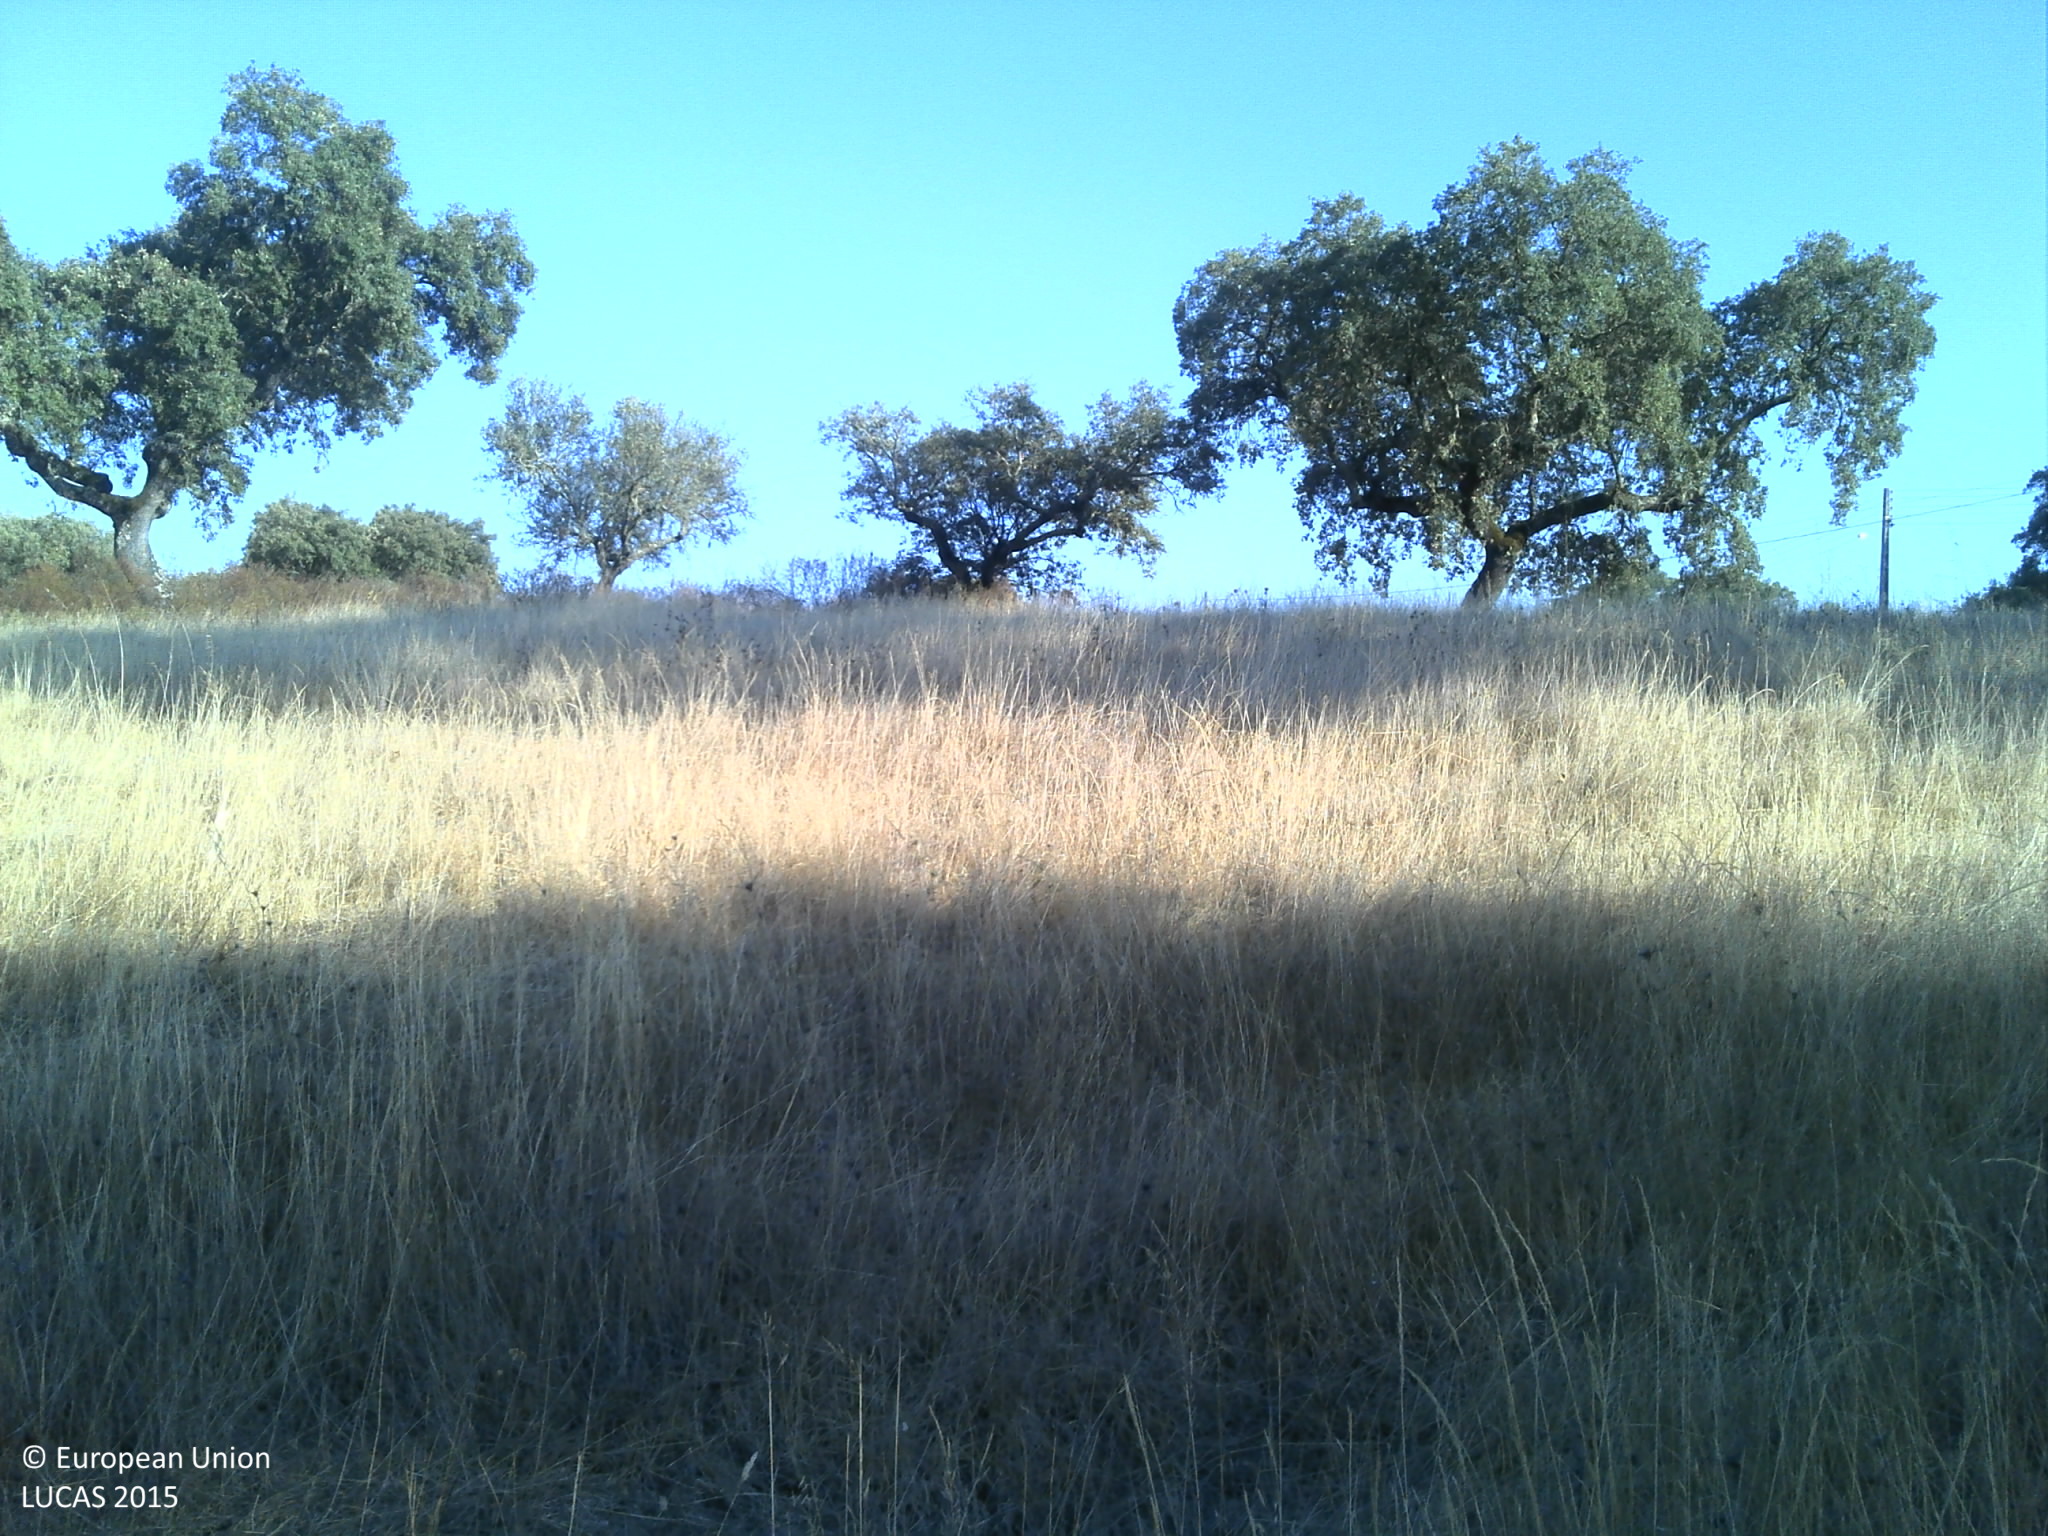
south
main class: Cropland
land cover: Olive groves
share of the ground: 25 - 50 %
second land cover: Grassland without tree/shrub cover
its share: 50 - 75 %
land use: Agriculture (excluding fallow land and kitchen gardens)
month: July
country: PT
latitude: 38.8668
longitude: -8.1810
